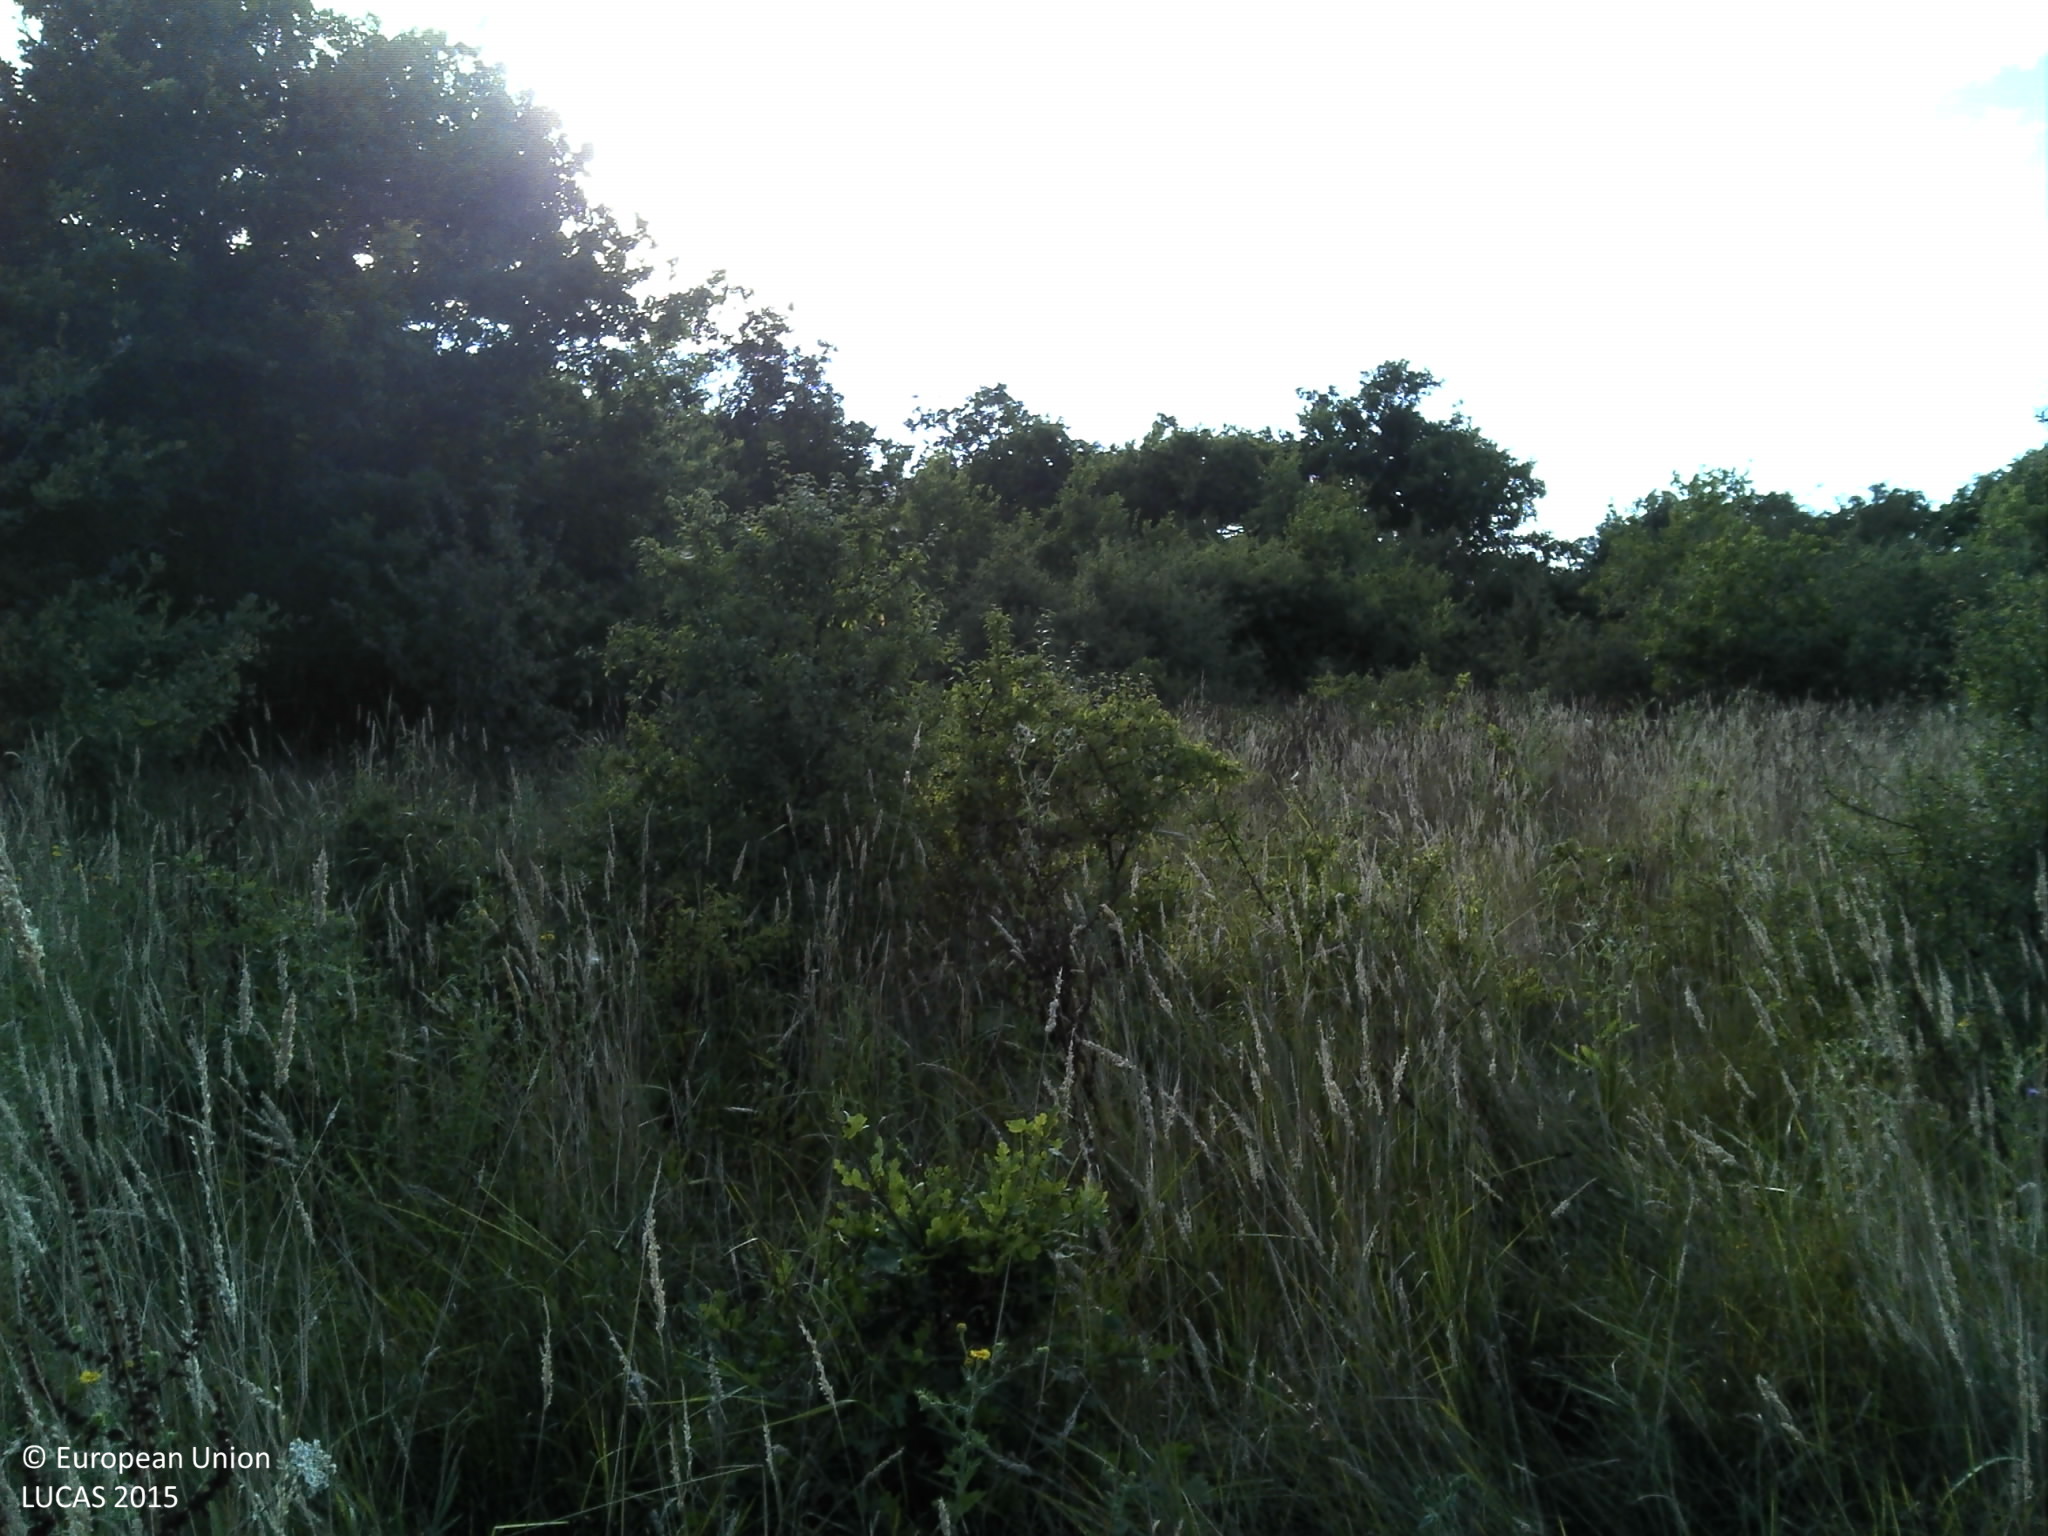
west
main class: Shrubland
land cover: Shrubland without tree cover
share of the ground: > 75 %
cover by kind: herbaceous plants 90 %, shrubs 10 %
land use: Semi-natural and natural areas not in use
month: July
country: FR
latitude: 45.4485
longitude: -1.0613
